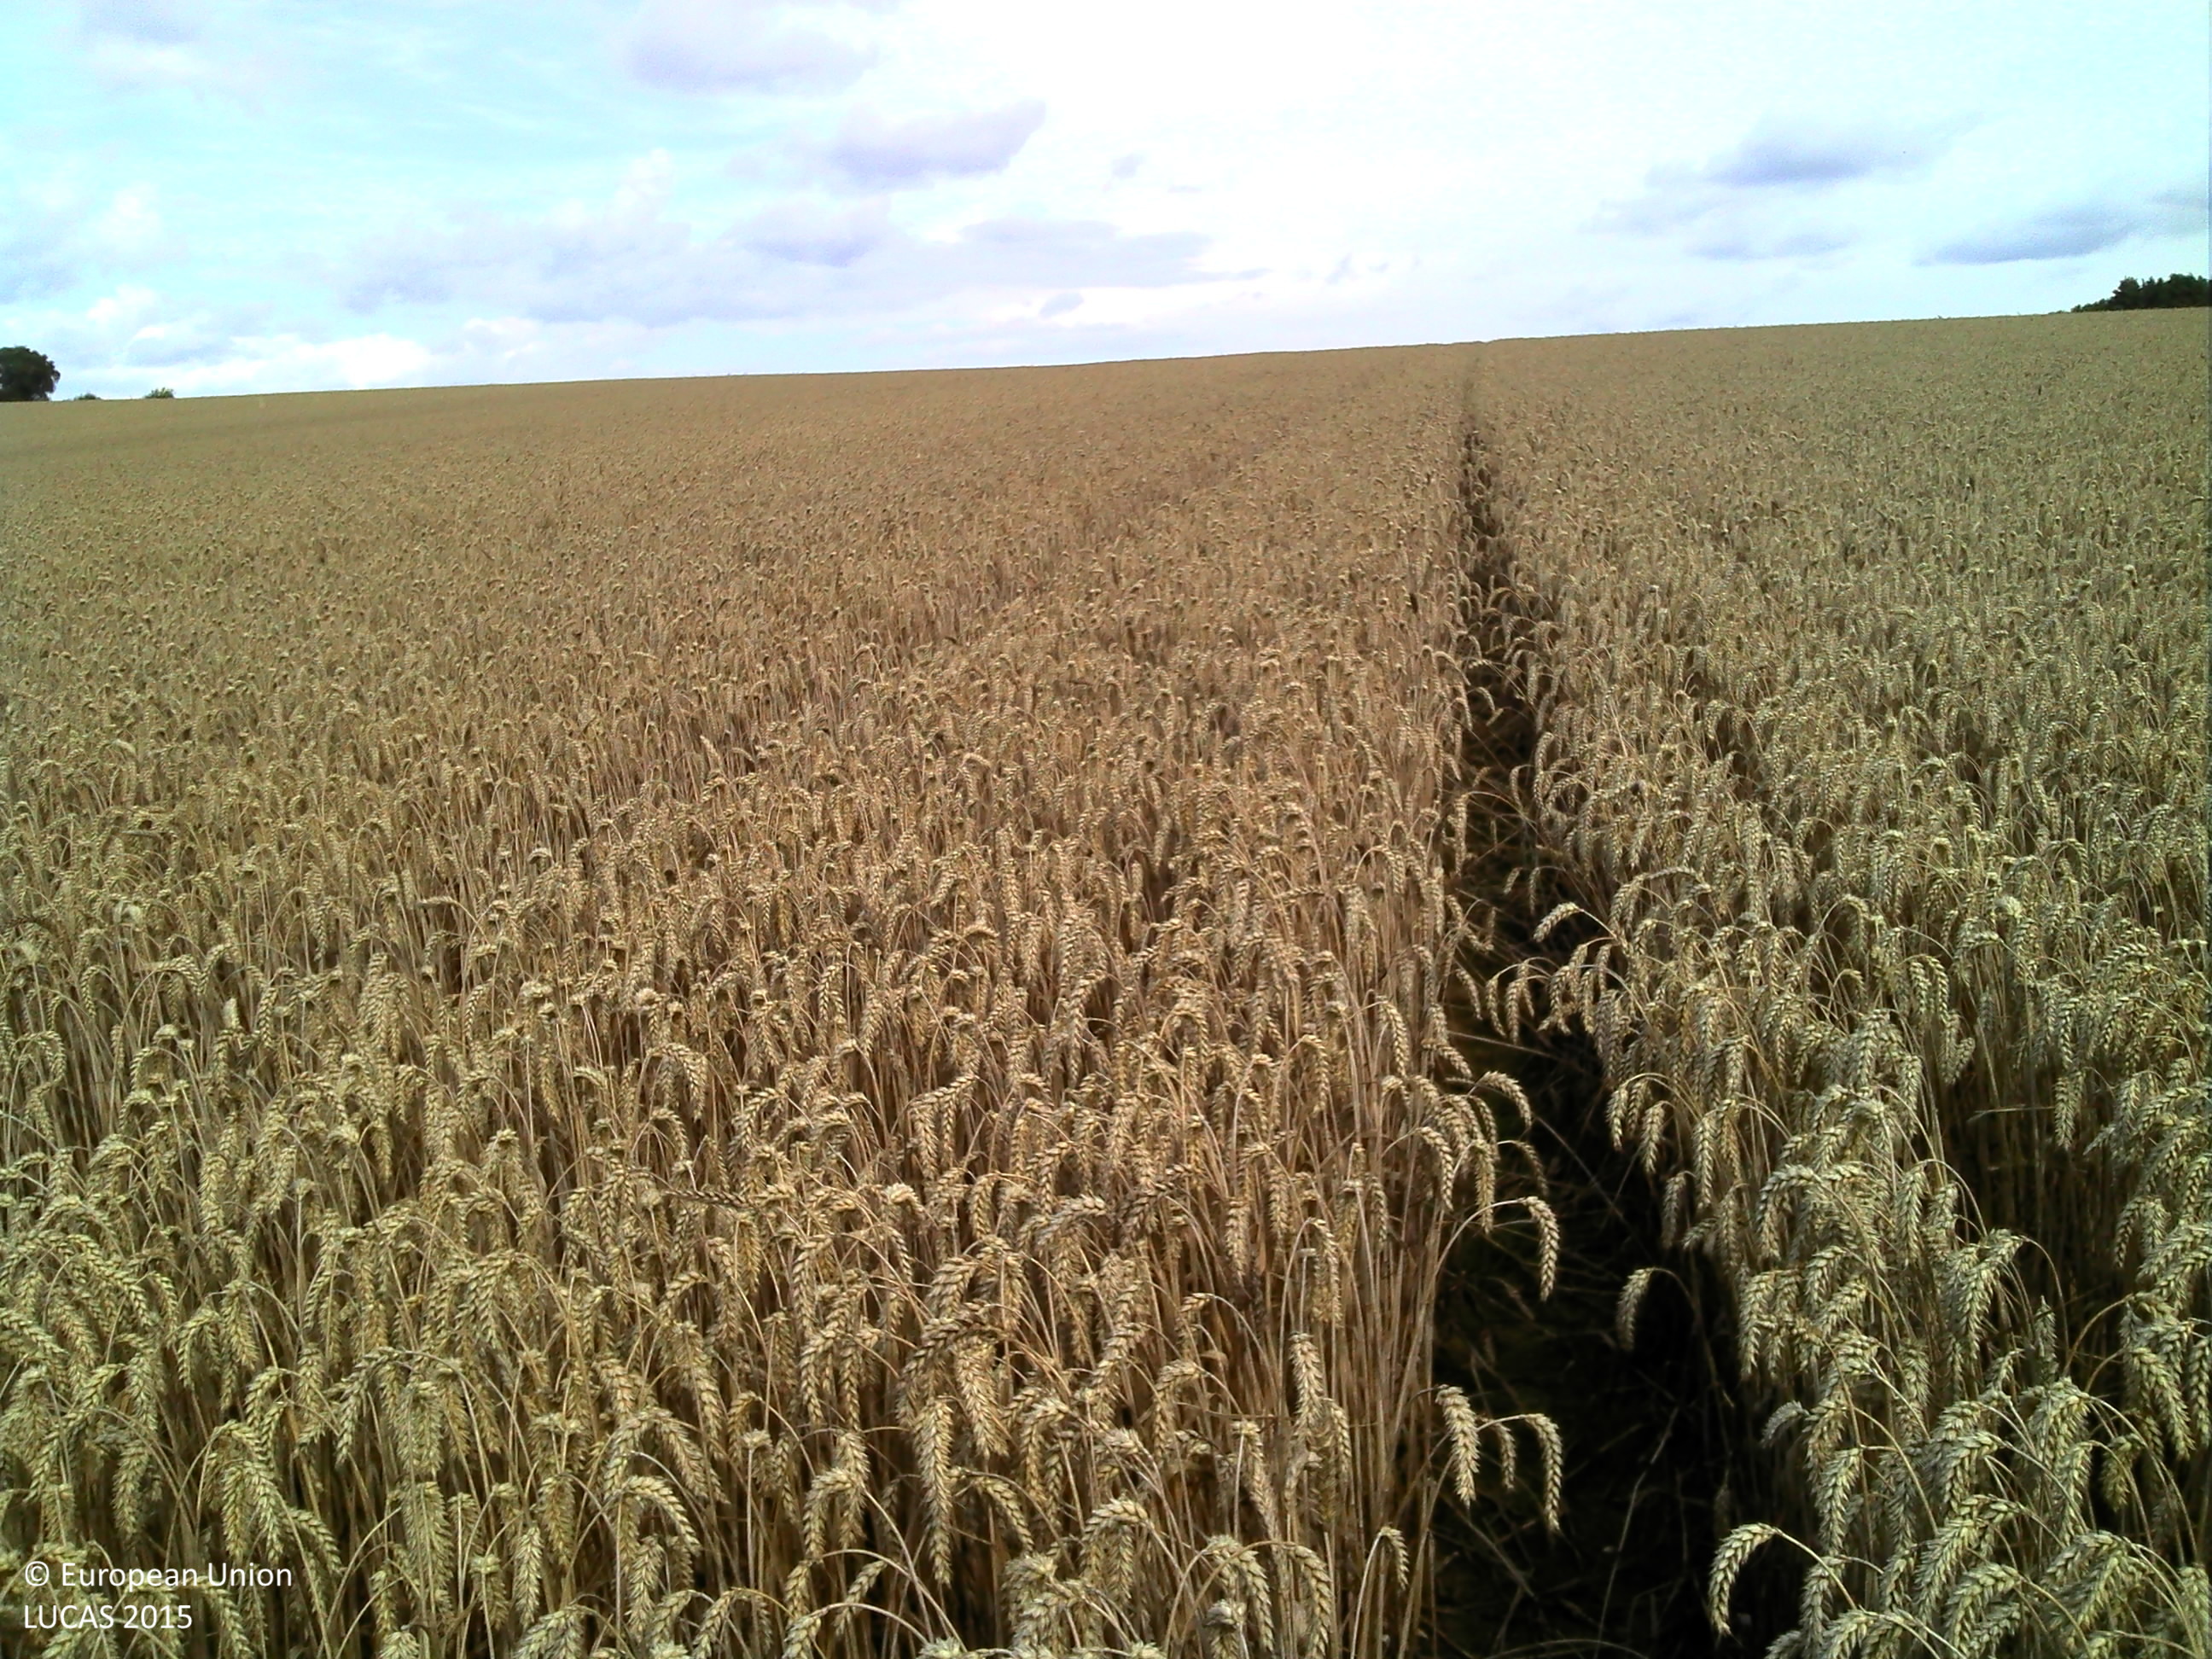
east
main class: Cropland
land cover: Common wheat
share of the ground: > 75 %
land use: Agriculture (excluding fallow land and kitchen gardens)
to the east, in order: Common wheat
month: July
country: FR
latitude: 47.9226
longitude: -3.0085
